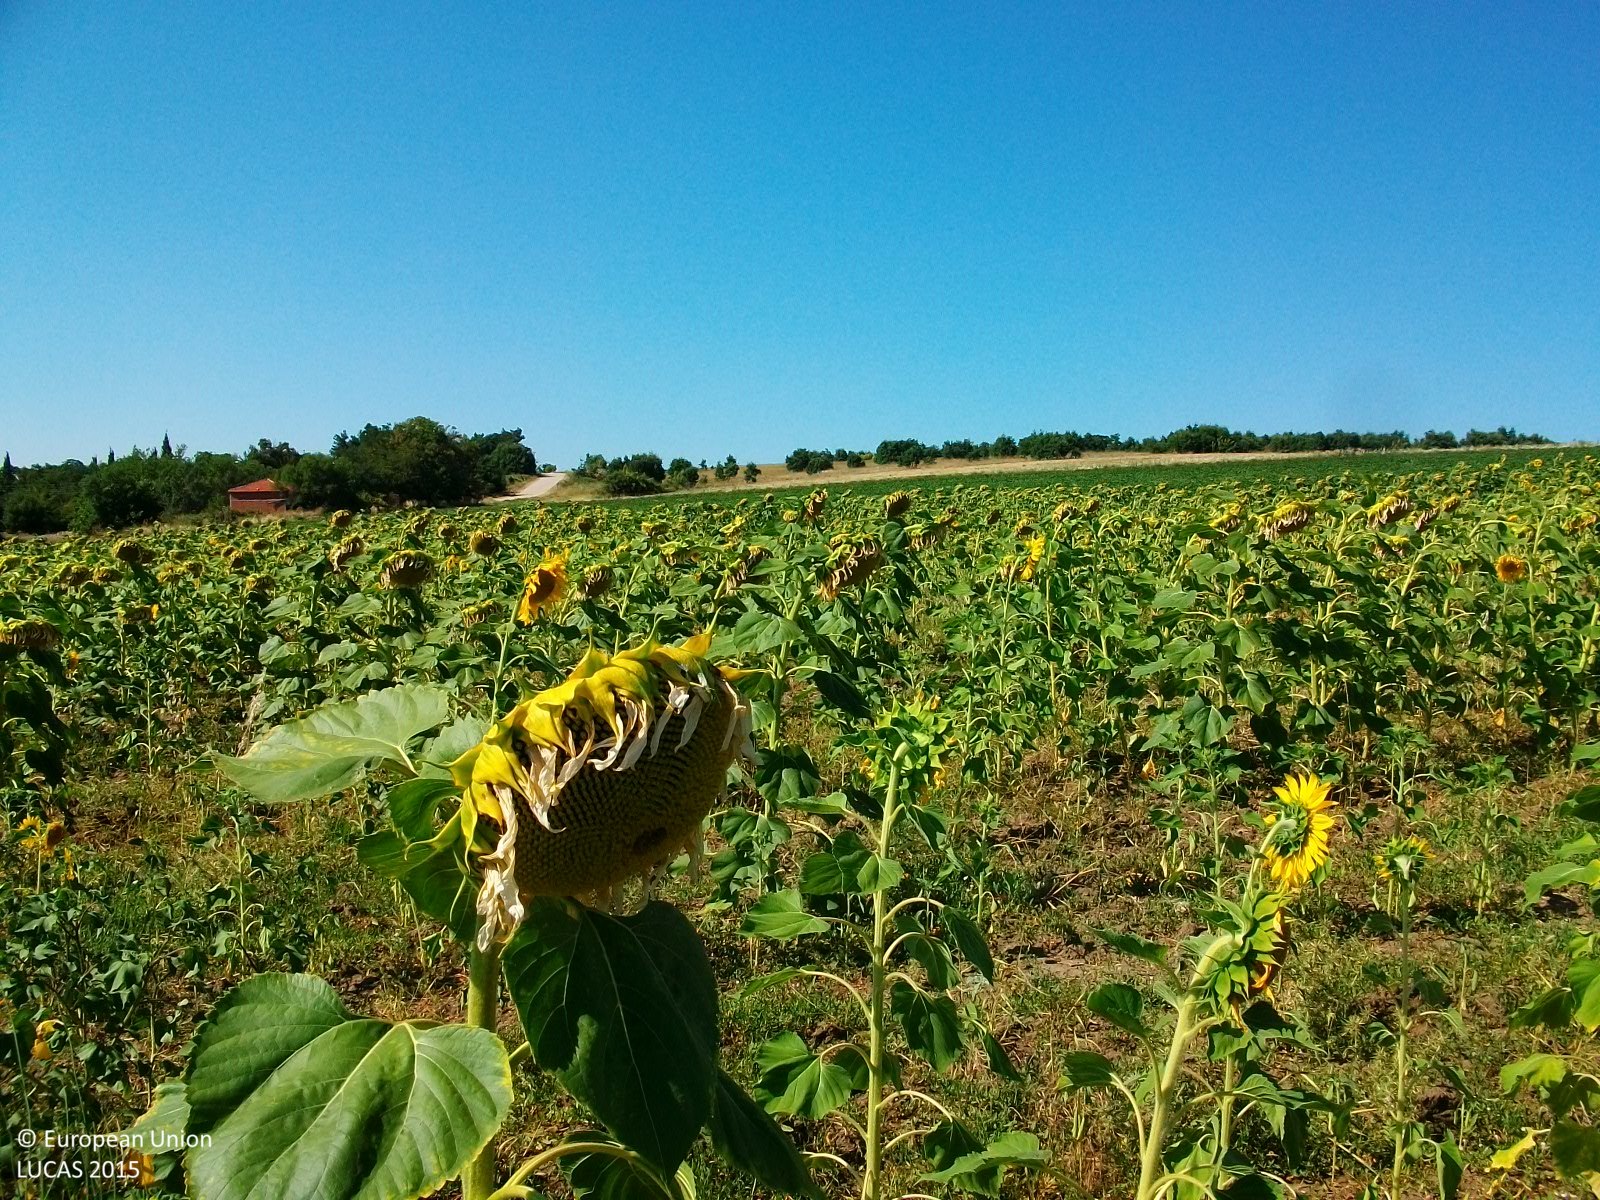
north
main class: Cropland
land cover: Sunflower
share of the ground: > 75 %
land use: Agriculture (excluding fallow land and kitchen gardens)
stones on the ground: < 10 %
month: July
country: GR
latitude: 41.4882
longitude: 26.3034
